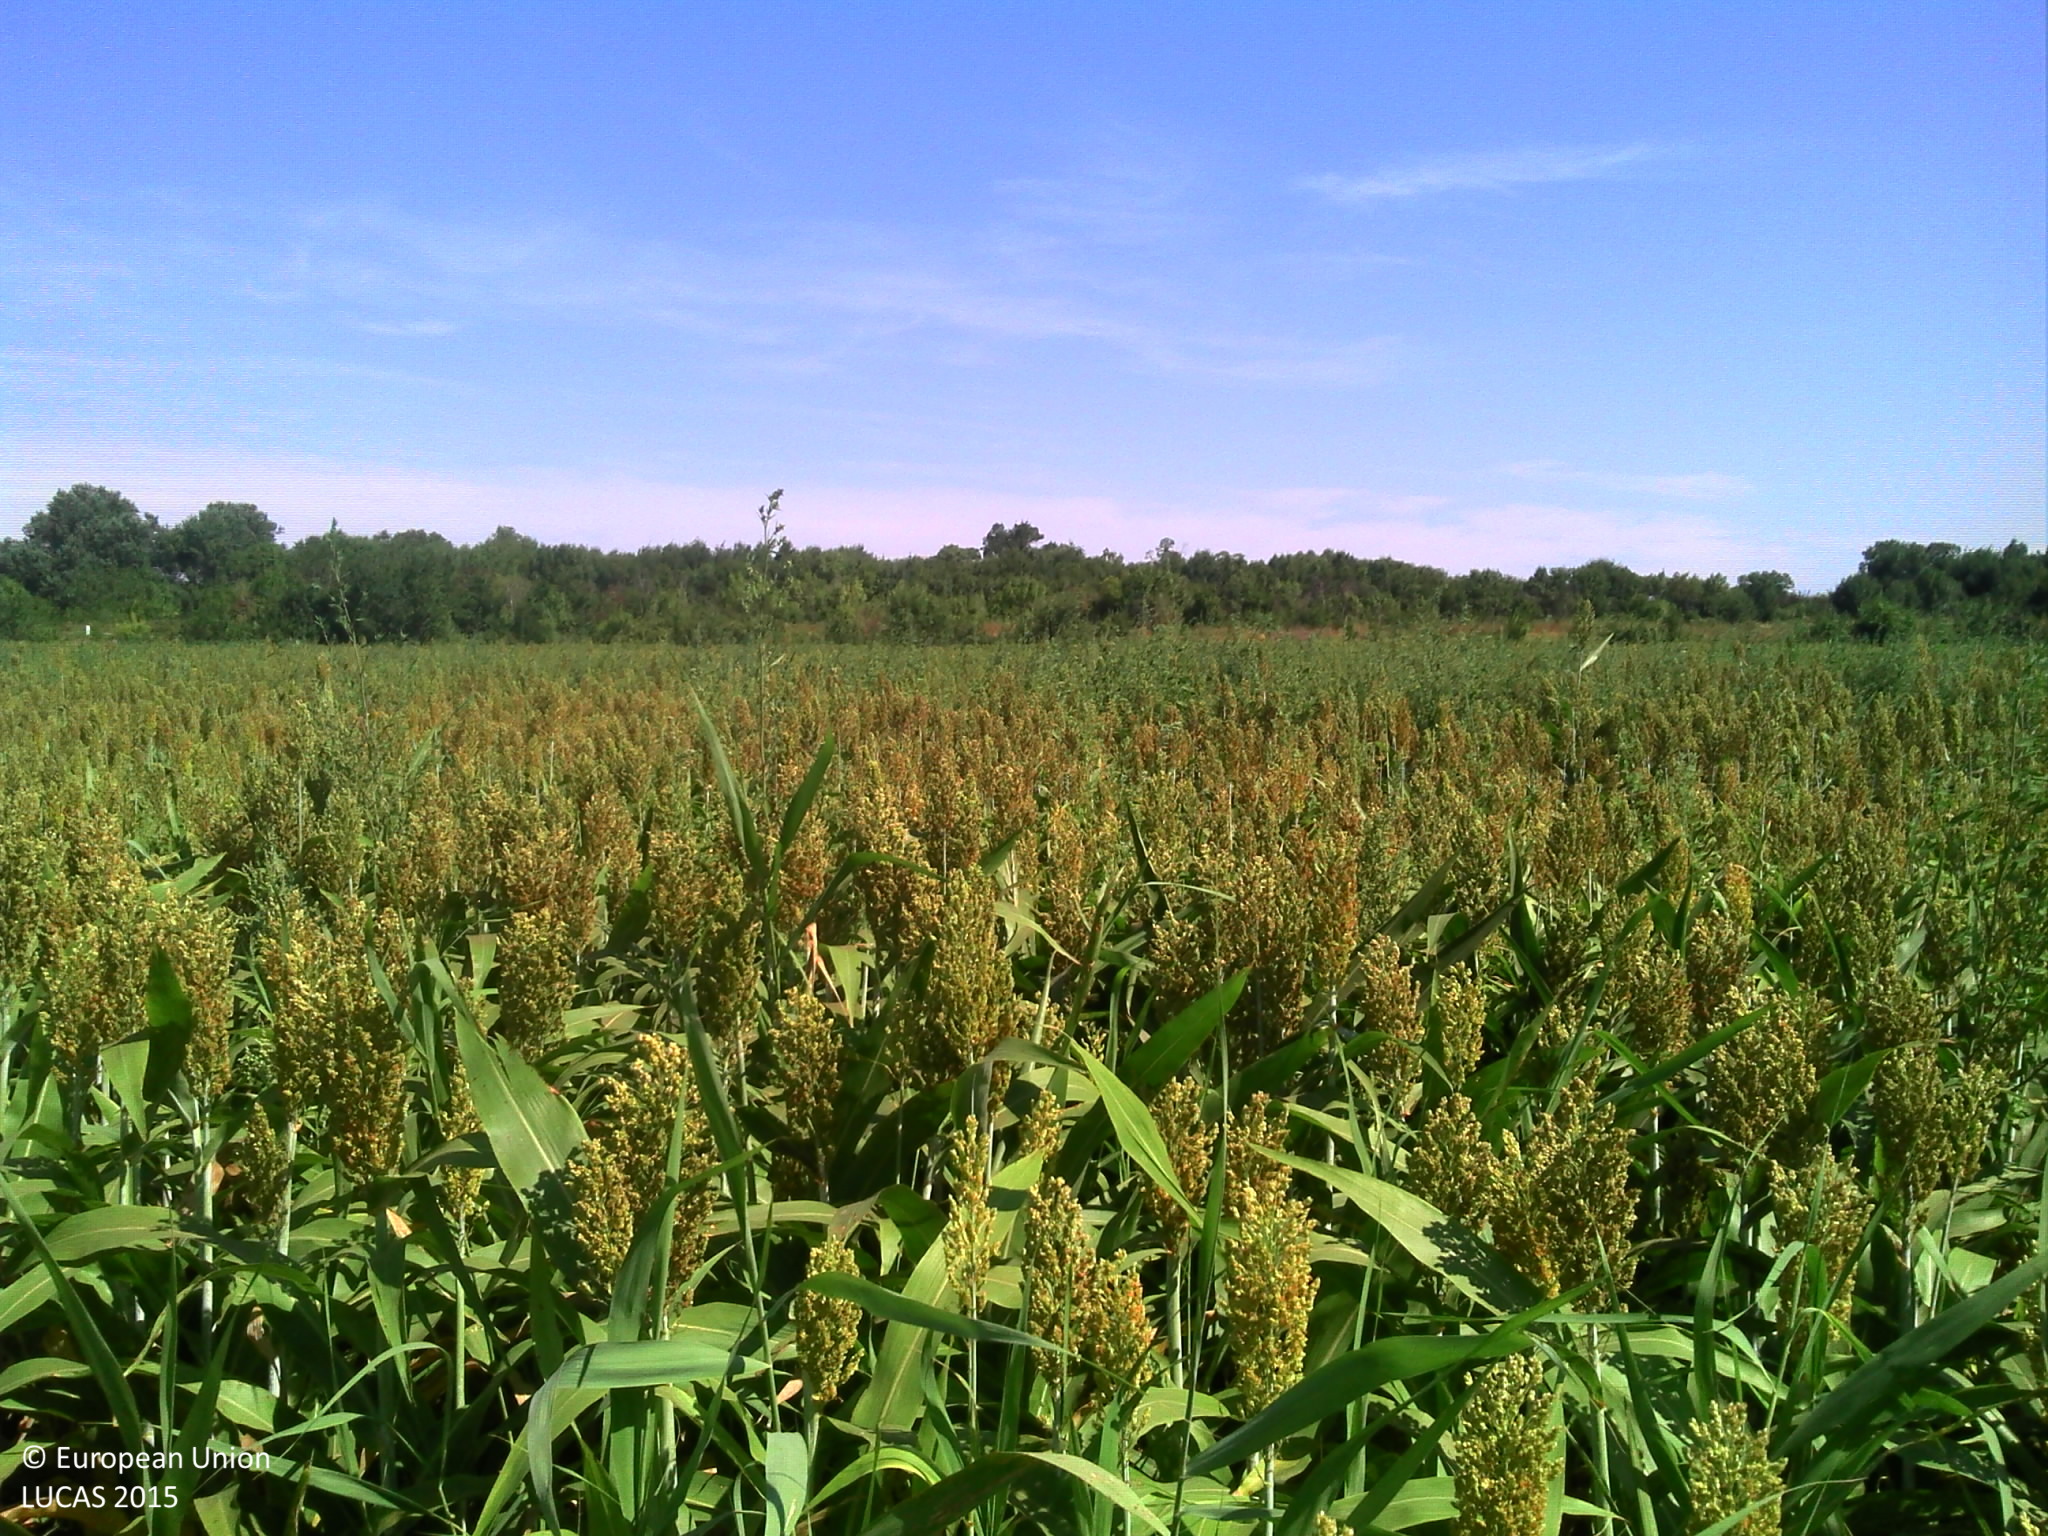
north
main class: Cropland
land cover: Other cereals
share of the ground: > 75 %
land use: Agriculture (excluding fallow land and kitchen gardens)
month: July
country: FR
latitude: 43.5823
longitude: 4.6969
